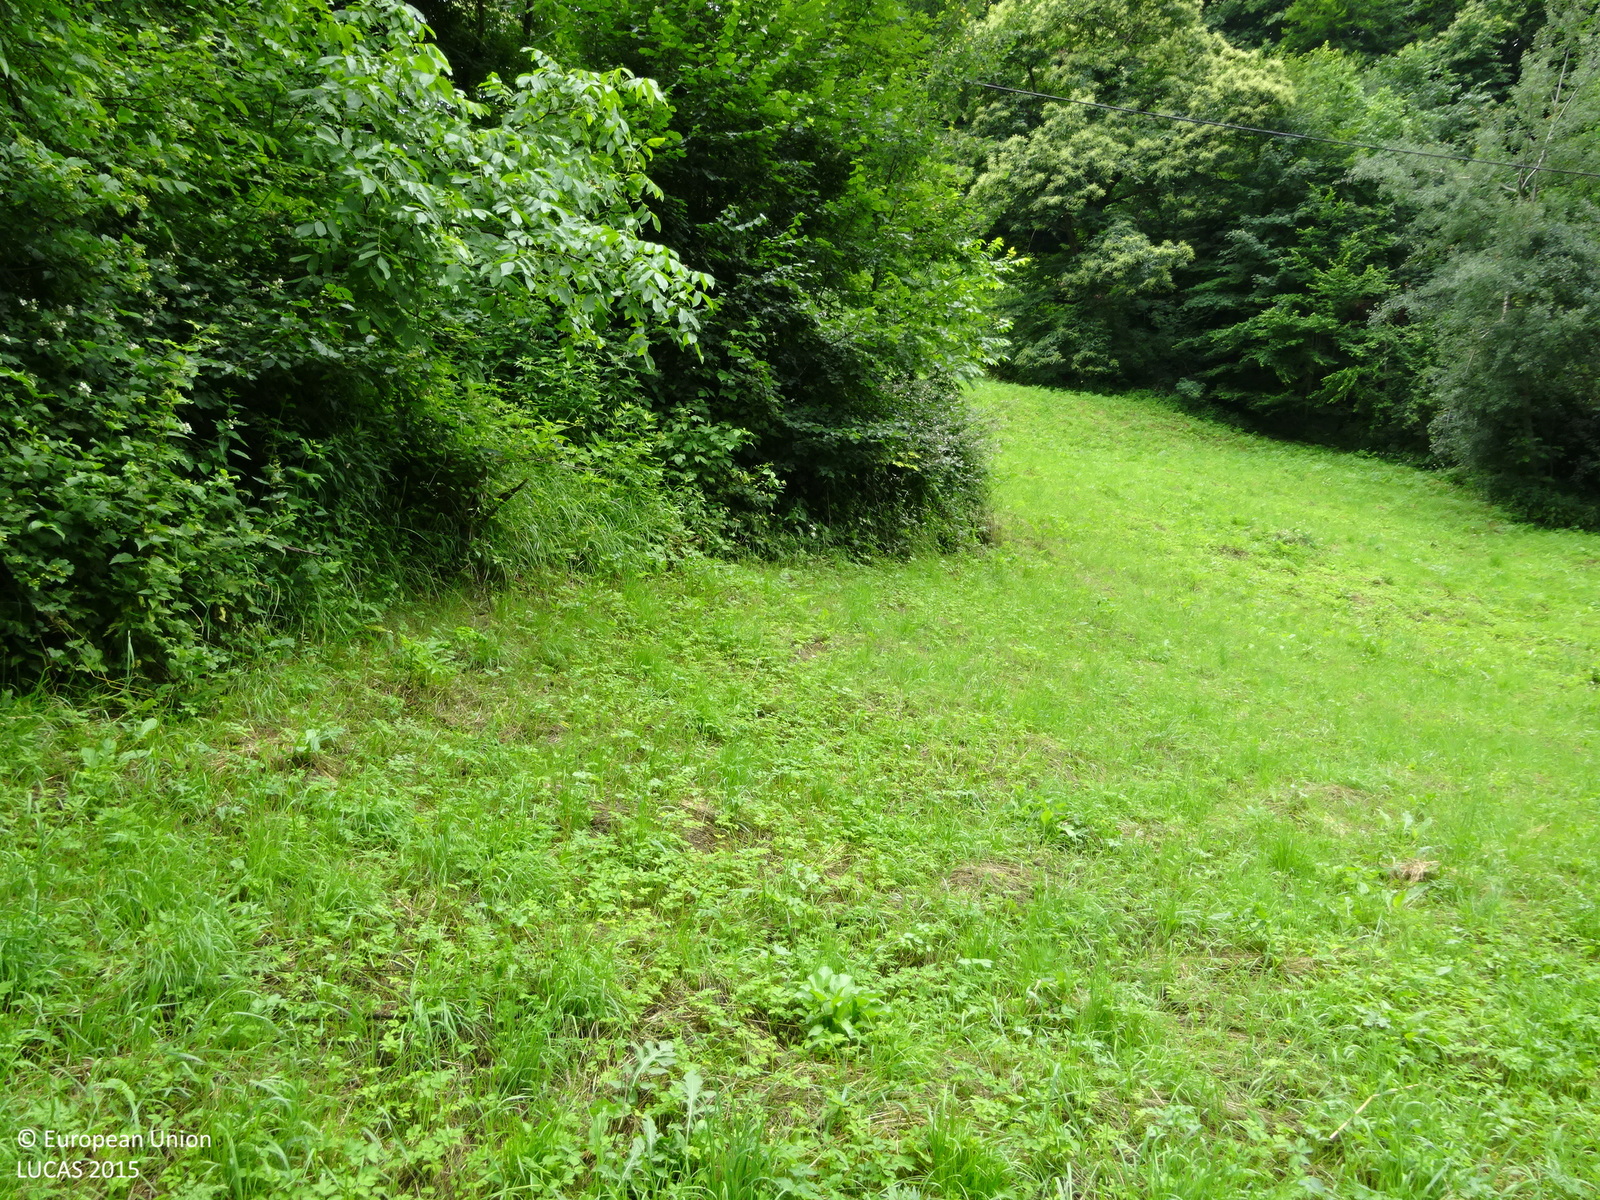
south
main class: Grassland
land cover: Grassland without tree/shrub cover
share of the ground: > 75 %
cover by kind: herbaceous plants 100 %
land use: Agriculture (excluding fallow land and kitchen gardens)
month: June
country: AT
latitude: 46.7174
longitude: 15.4545
